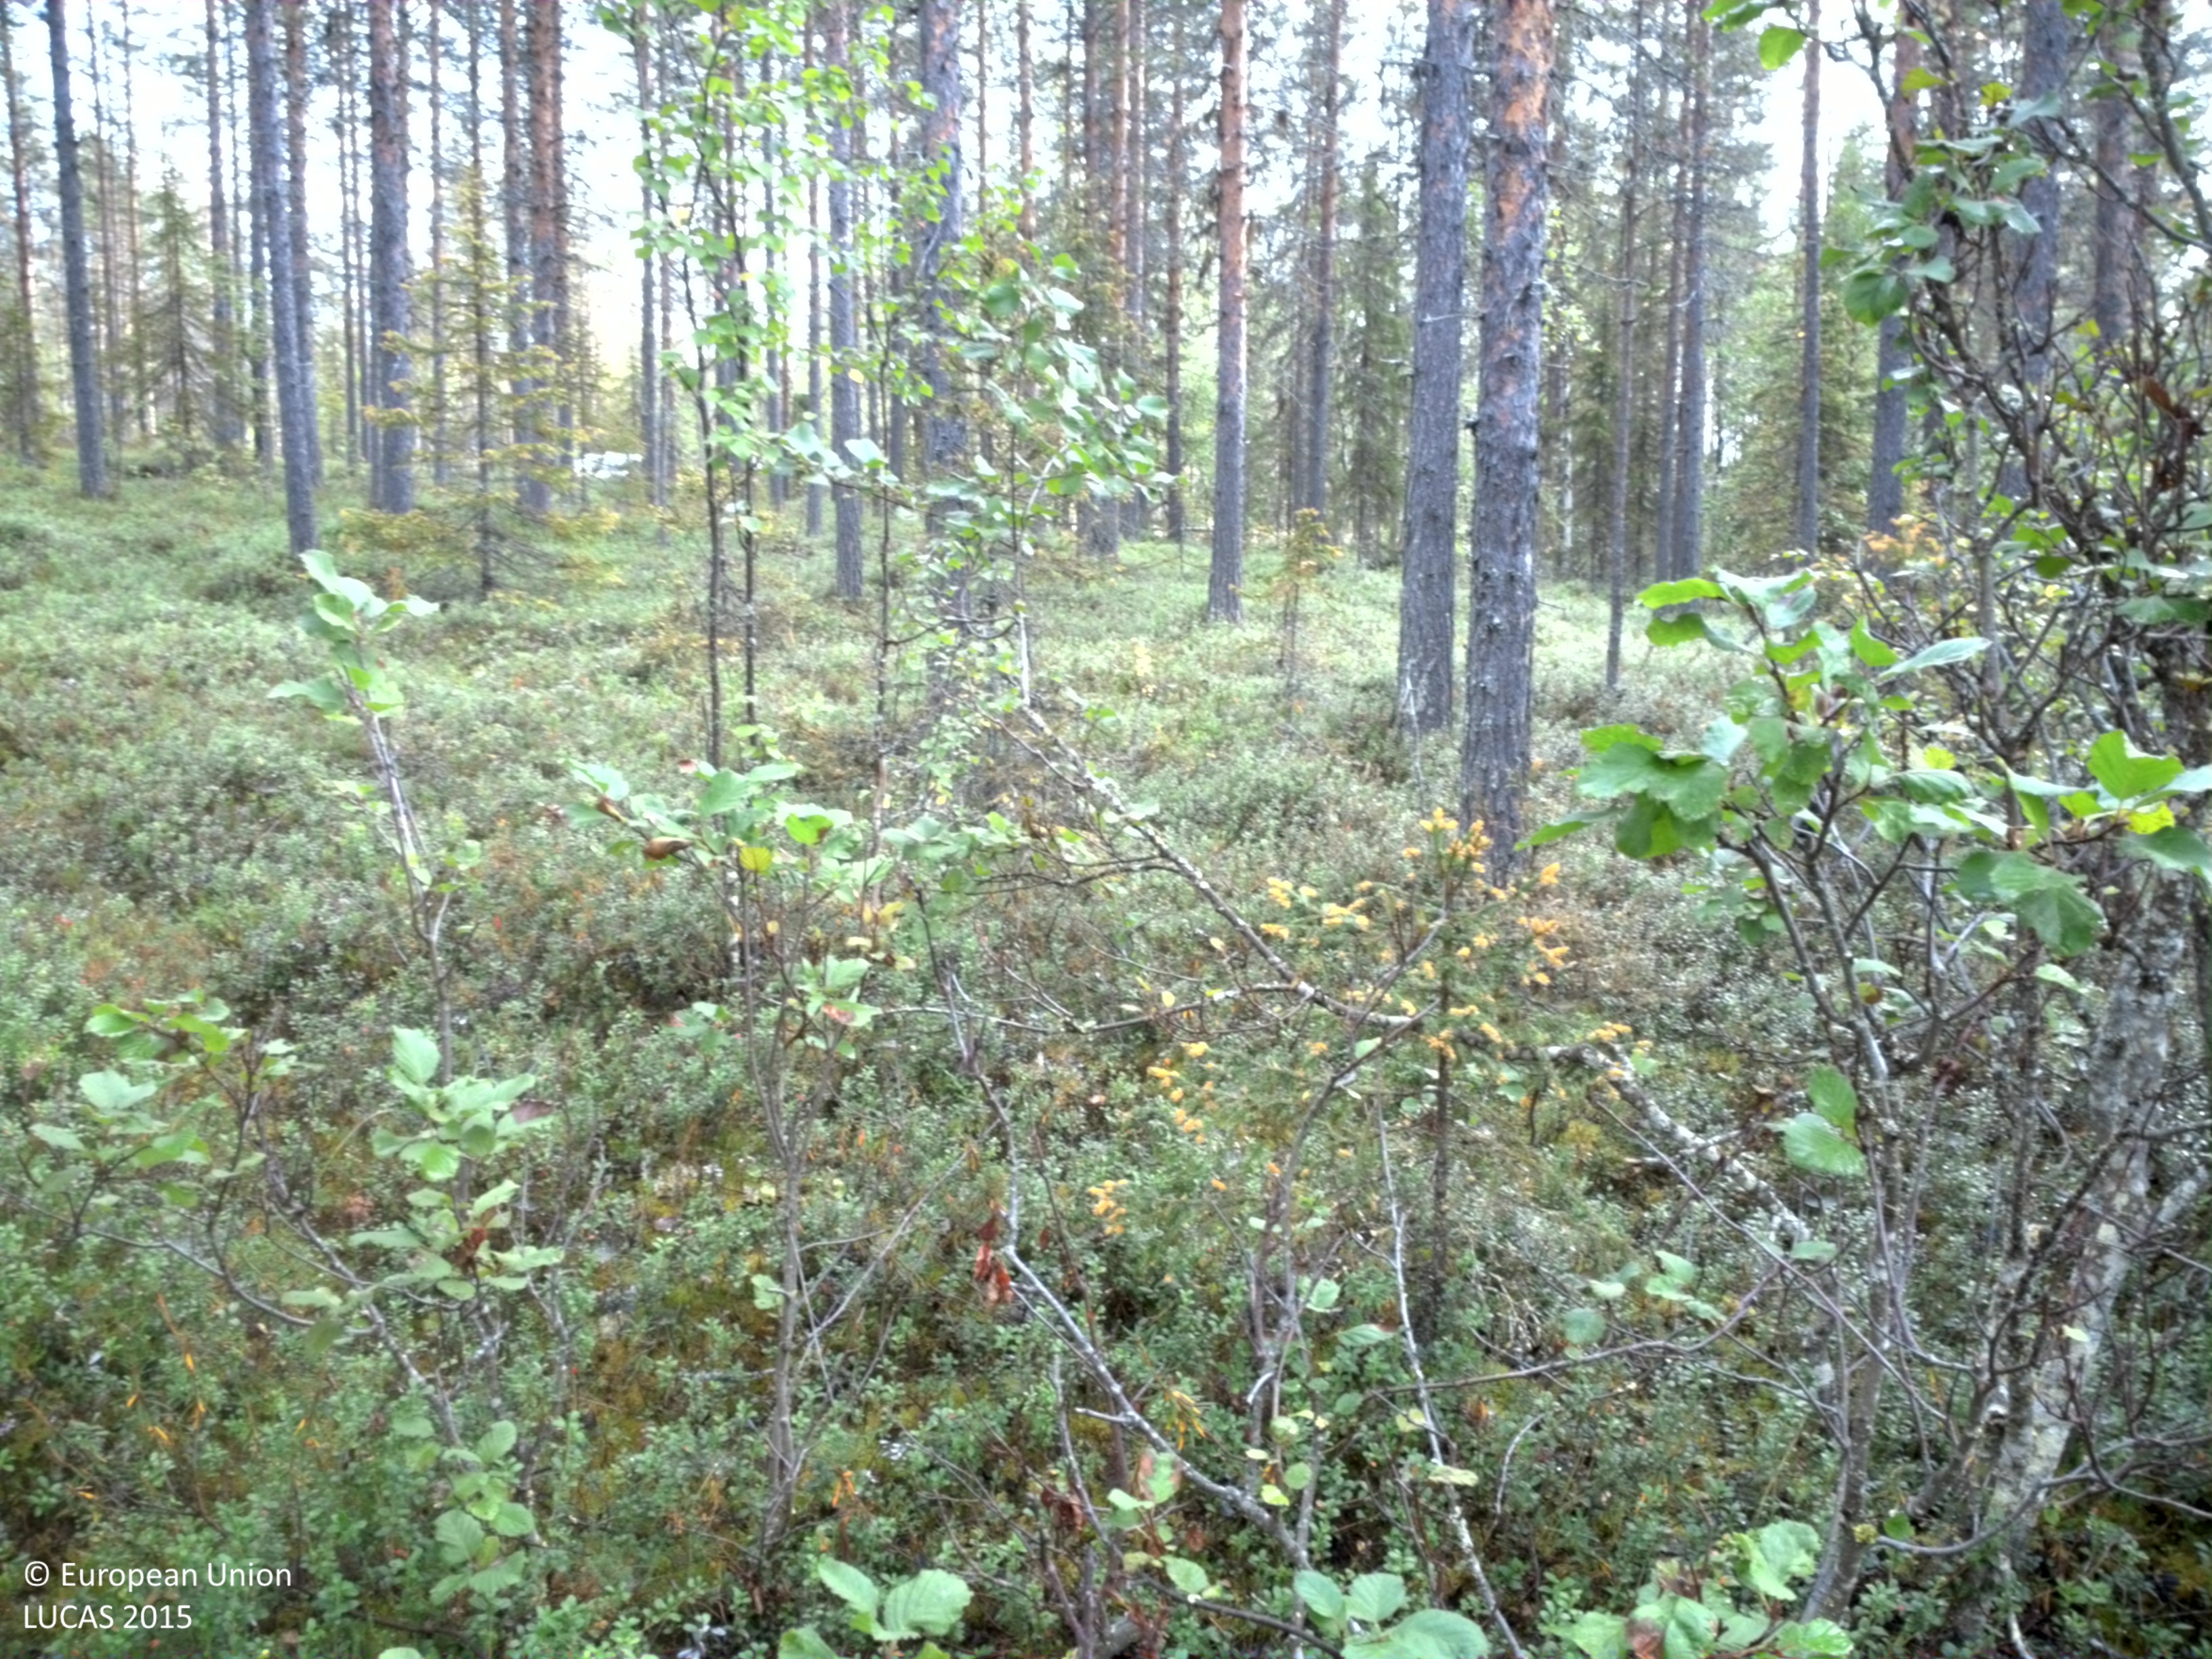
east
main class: Woodland
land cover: Pine dominated coniferous woodland
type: boreal forest
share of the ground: 25 - 50 %
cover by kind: shrubs 65 %, coniferous forest trees 30 %, broadleaved forest trees 5 %
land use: Forestry
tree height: > 5 m
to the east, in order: Pine dominated coniferous woodland; Spruce dominated mixed woodland; Sand; Tracks; Sand; Shrubland with sparse tree cover; Pine dominated coniferous woodland
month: August
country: SE
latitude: 66.5855
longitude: 19.6264
